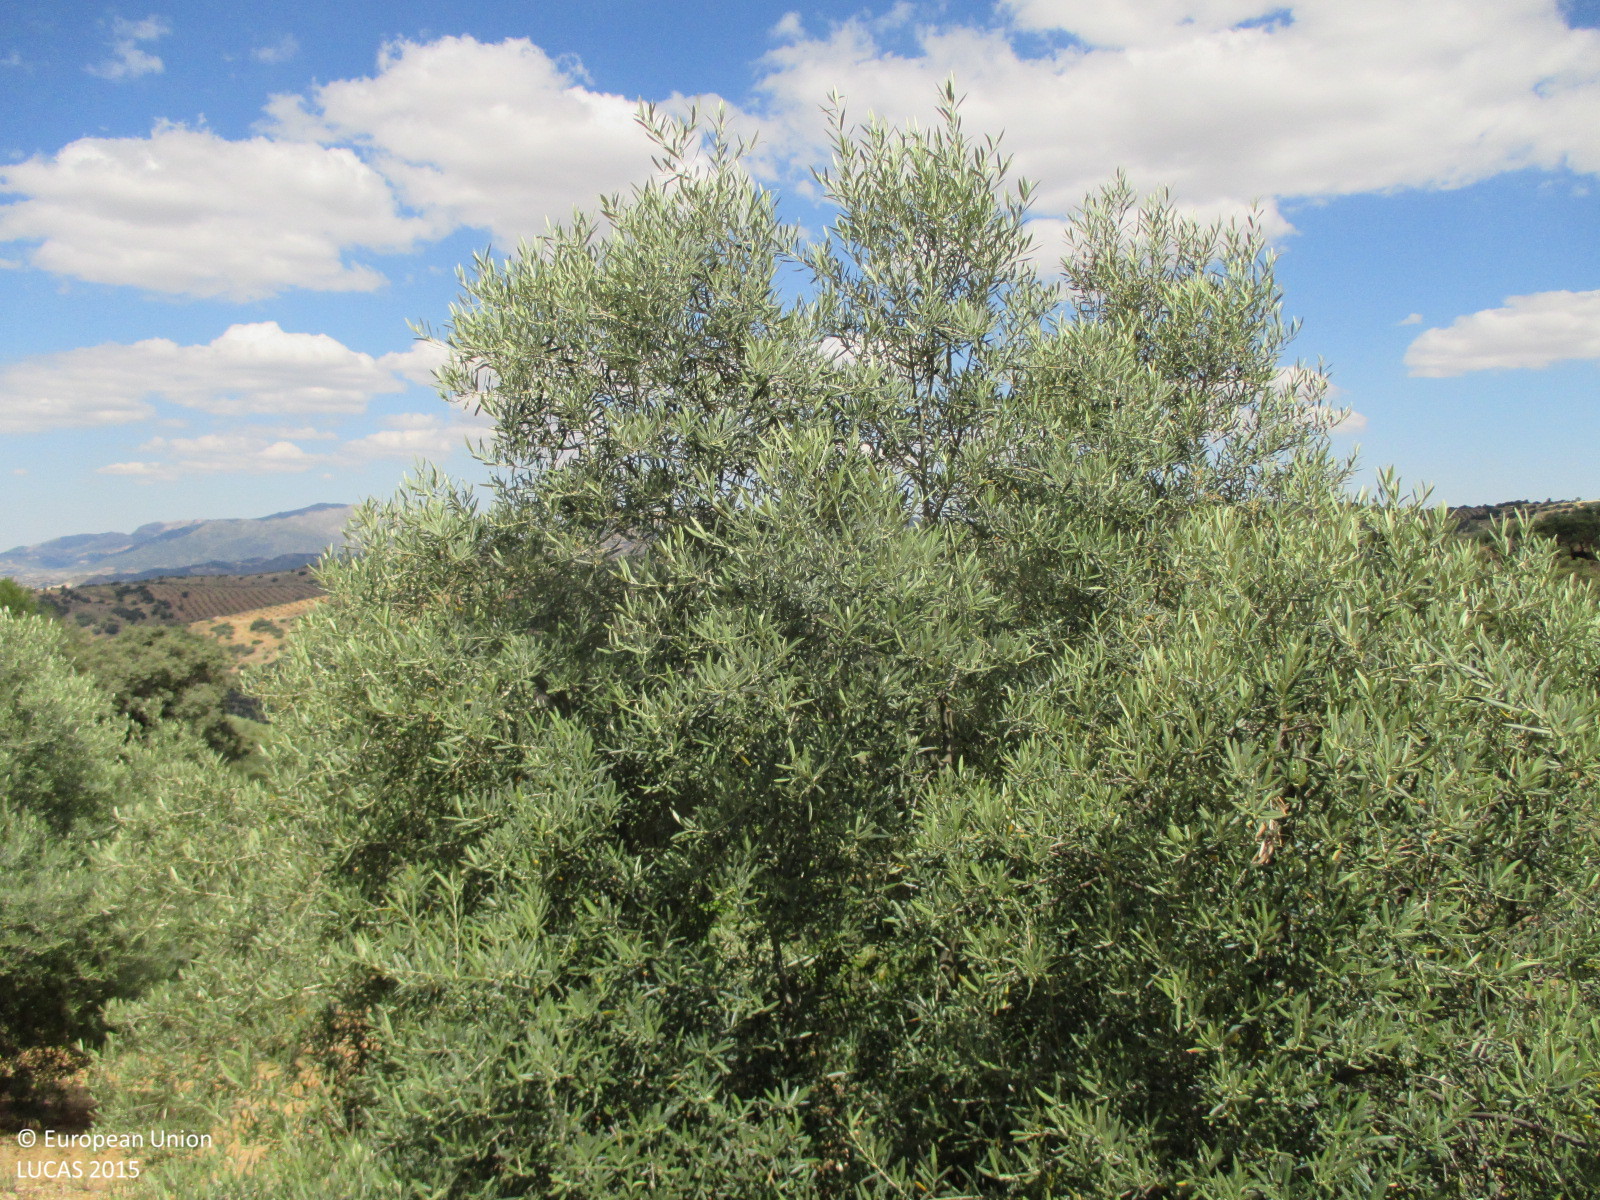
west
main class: Cropland
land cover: Olive groves
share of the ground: 10 - 25 %
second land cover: Other bare soil
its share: > 75 %
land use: Agriculture (excluding fallow land and kitchen gardens)
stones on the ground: < 10 %
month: June
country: ES
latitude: 37.3565
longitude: -4.0756
